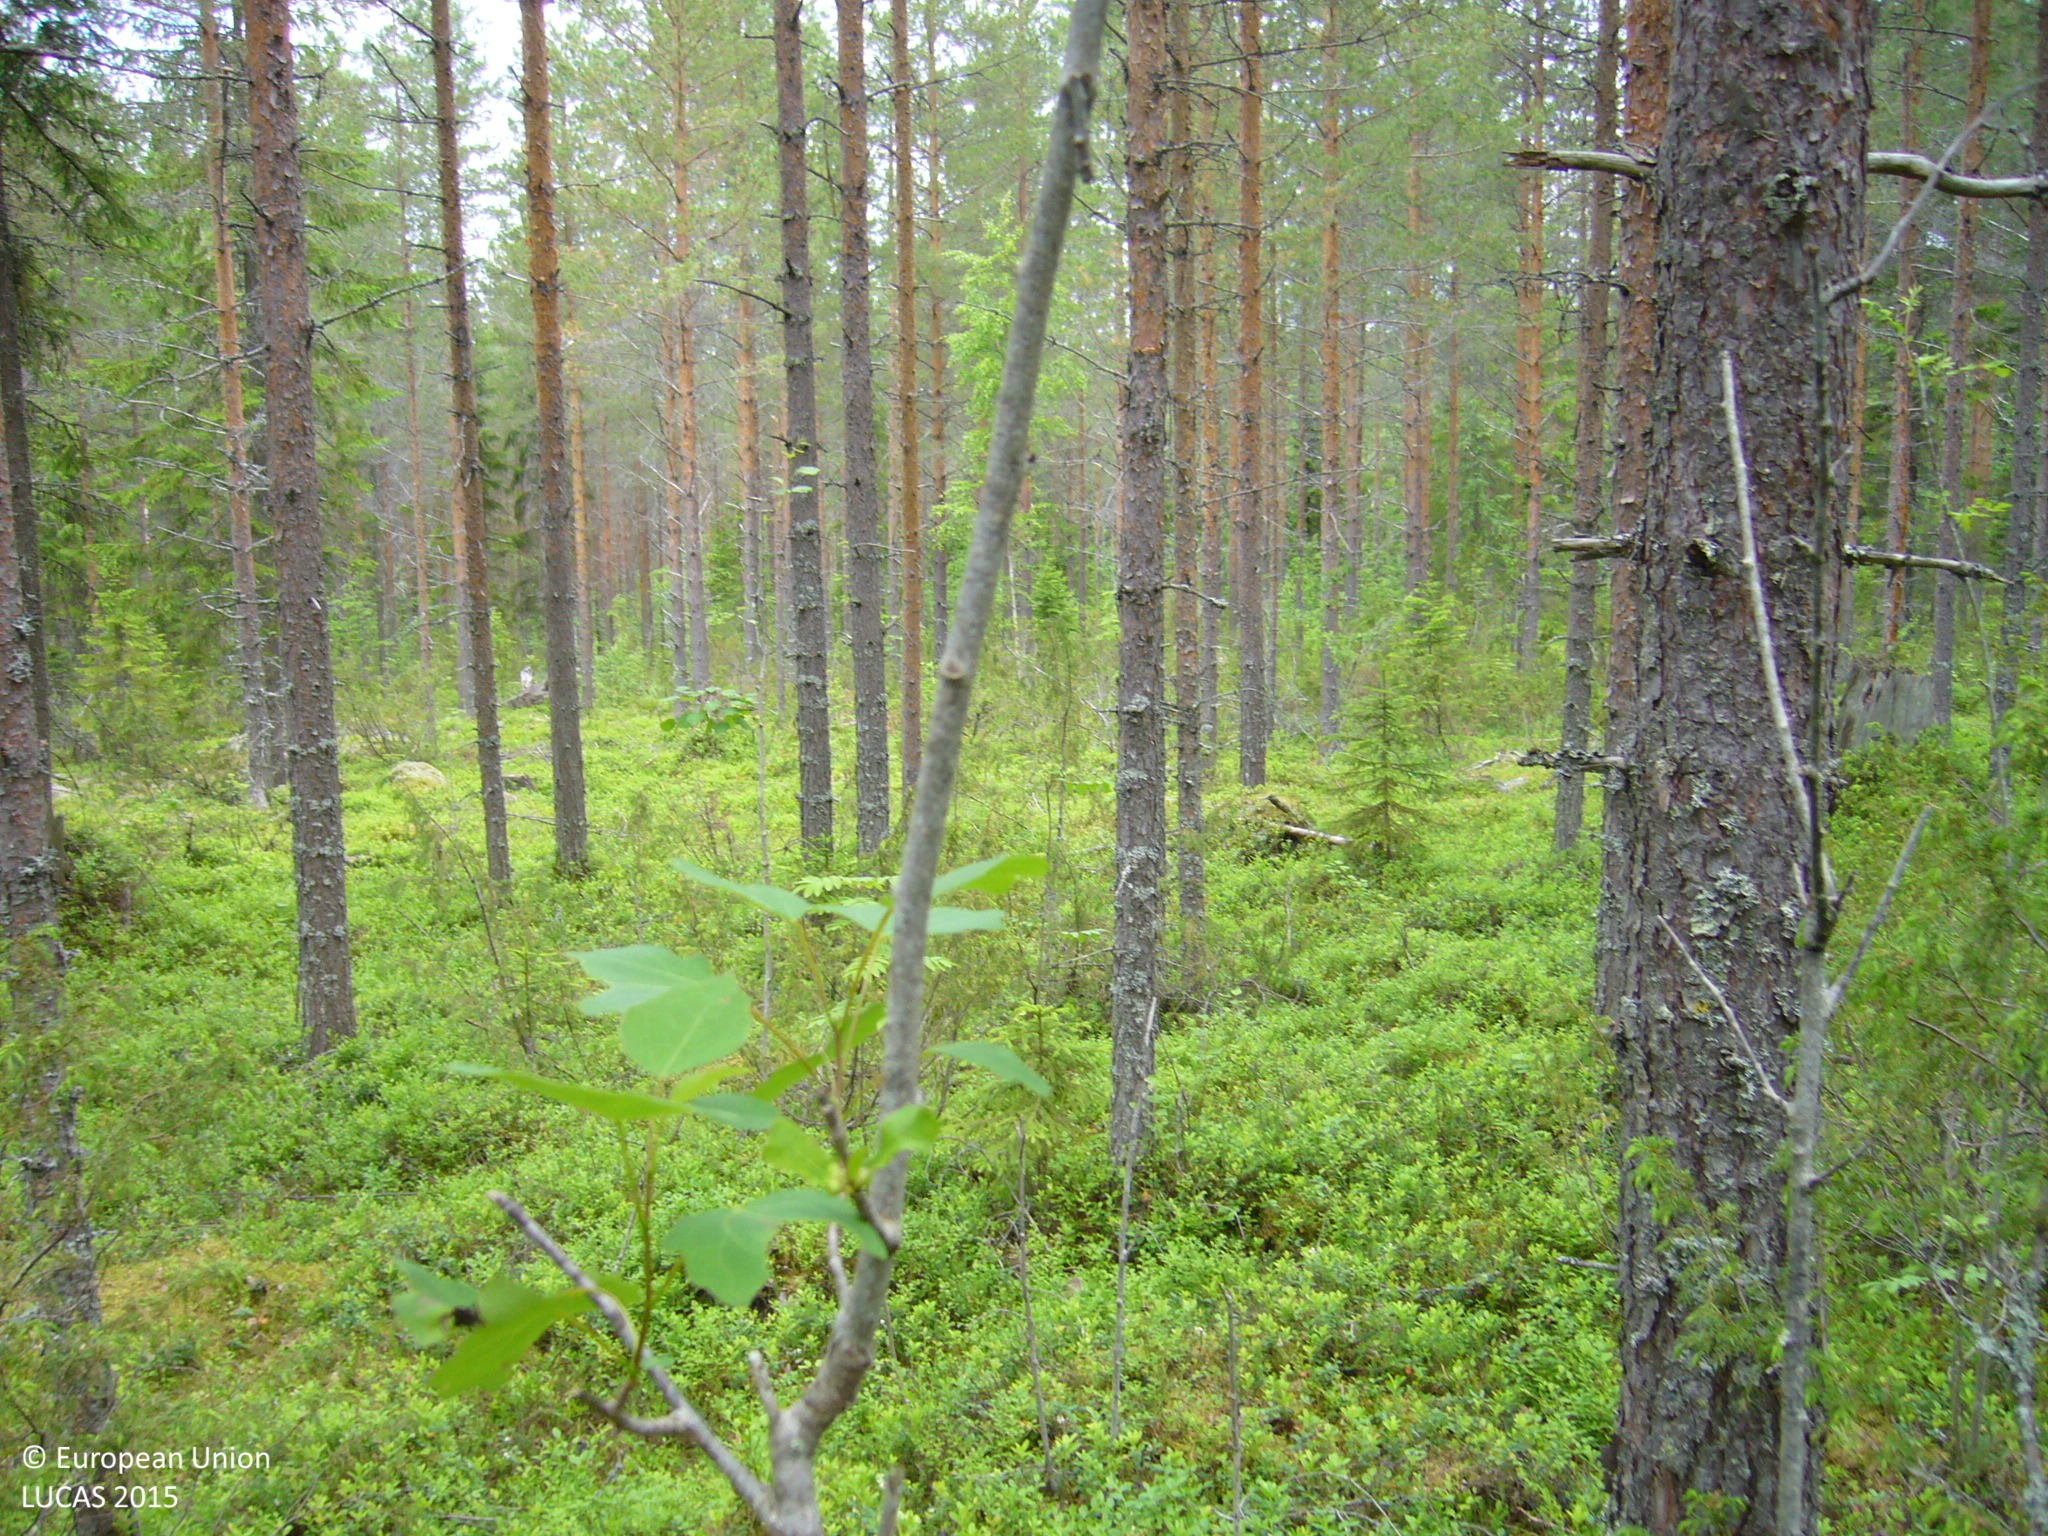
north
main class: Woodland
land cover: Pine dominated coniferous woodland
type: boreal forest
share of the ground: 50 - 75 %
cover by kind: coniferous forest trees 60 %, shrubs 40 %
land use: Forestry
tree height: > 5 m
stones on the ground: 25 - 50 %
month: July
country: FI
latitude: 63.4266
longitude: 26.2090
